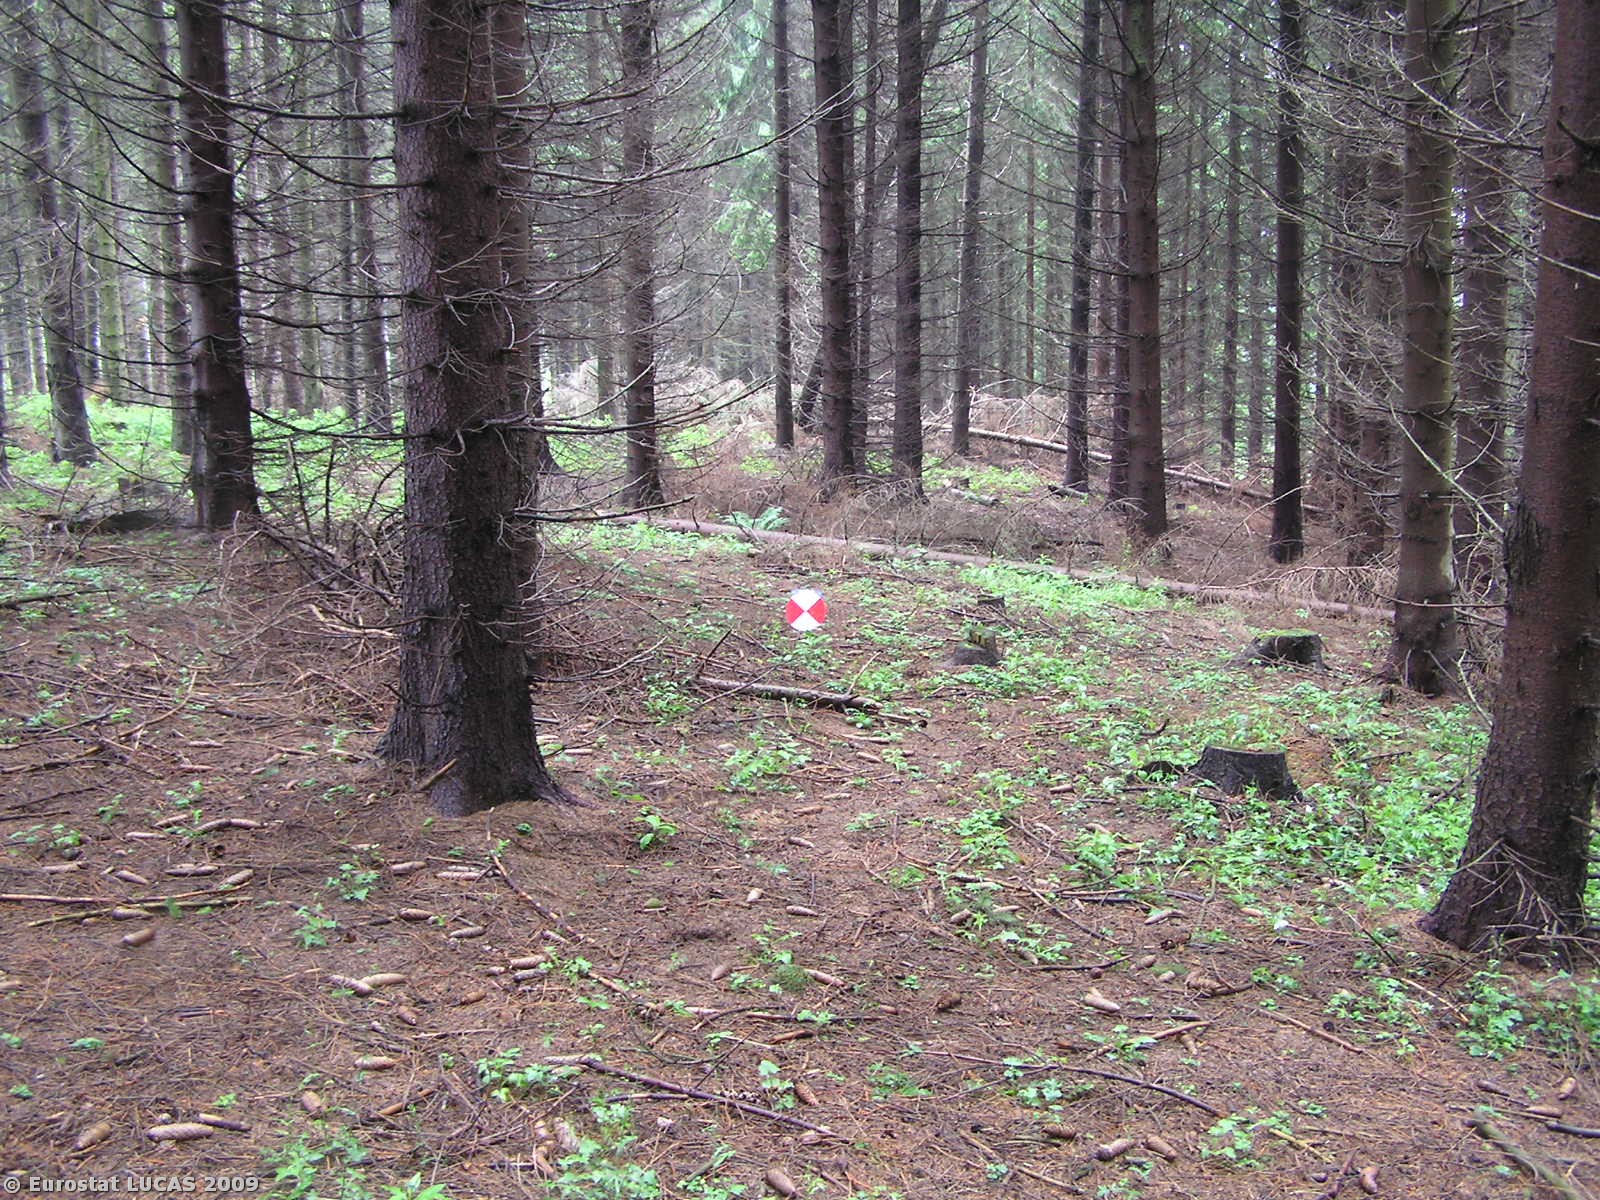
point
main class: Woodland
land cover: Coniferous woodland
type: hemiboreal forest and nemoral coniferous forest and mixed broadleaved-coniferous forest
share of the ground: > 75 %
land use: Forestry
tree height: > 5 m
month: May
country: CZ
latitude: 50.1395
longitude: 17.4418
